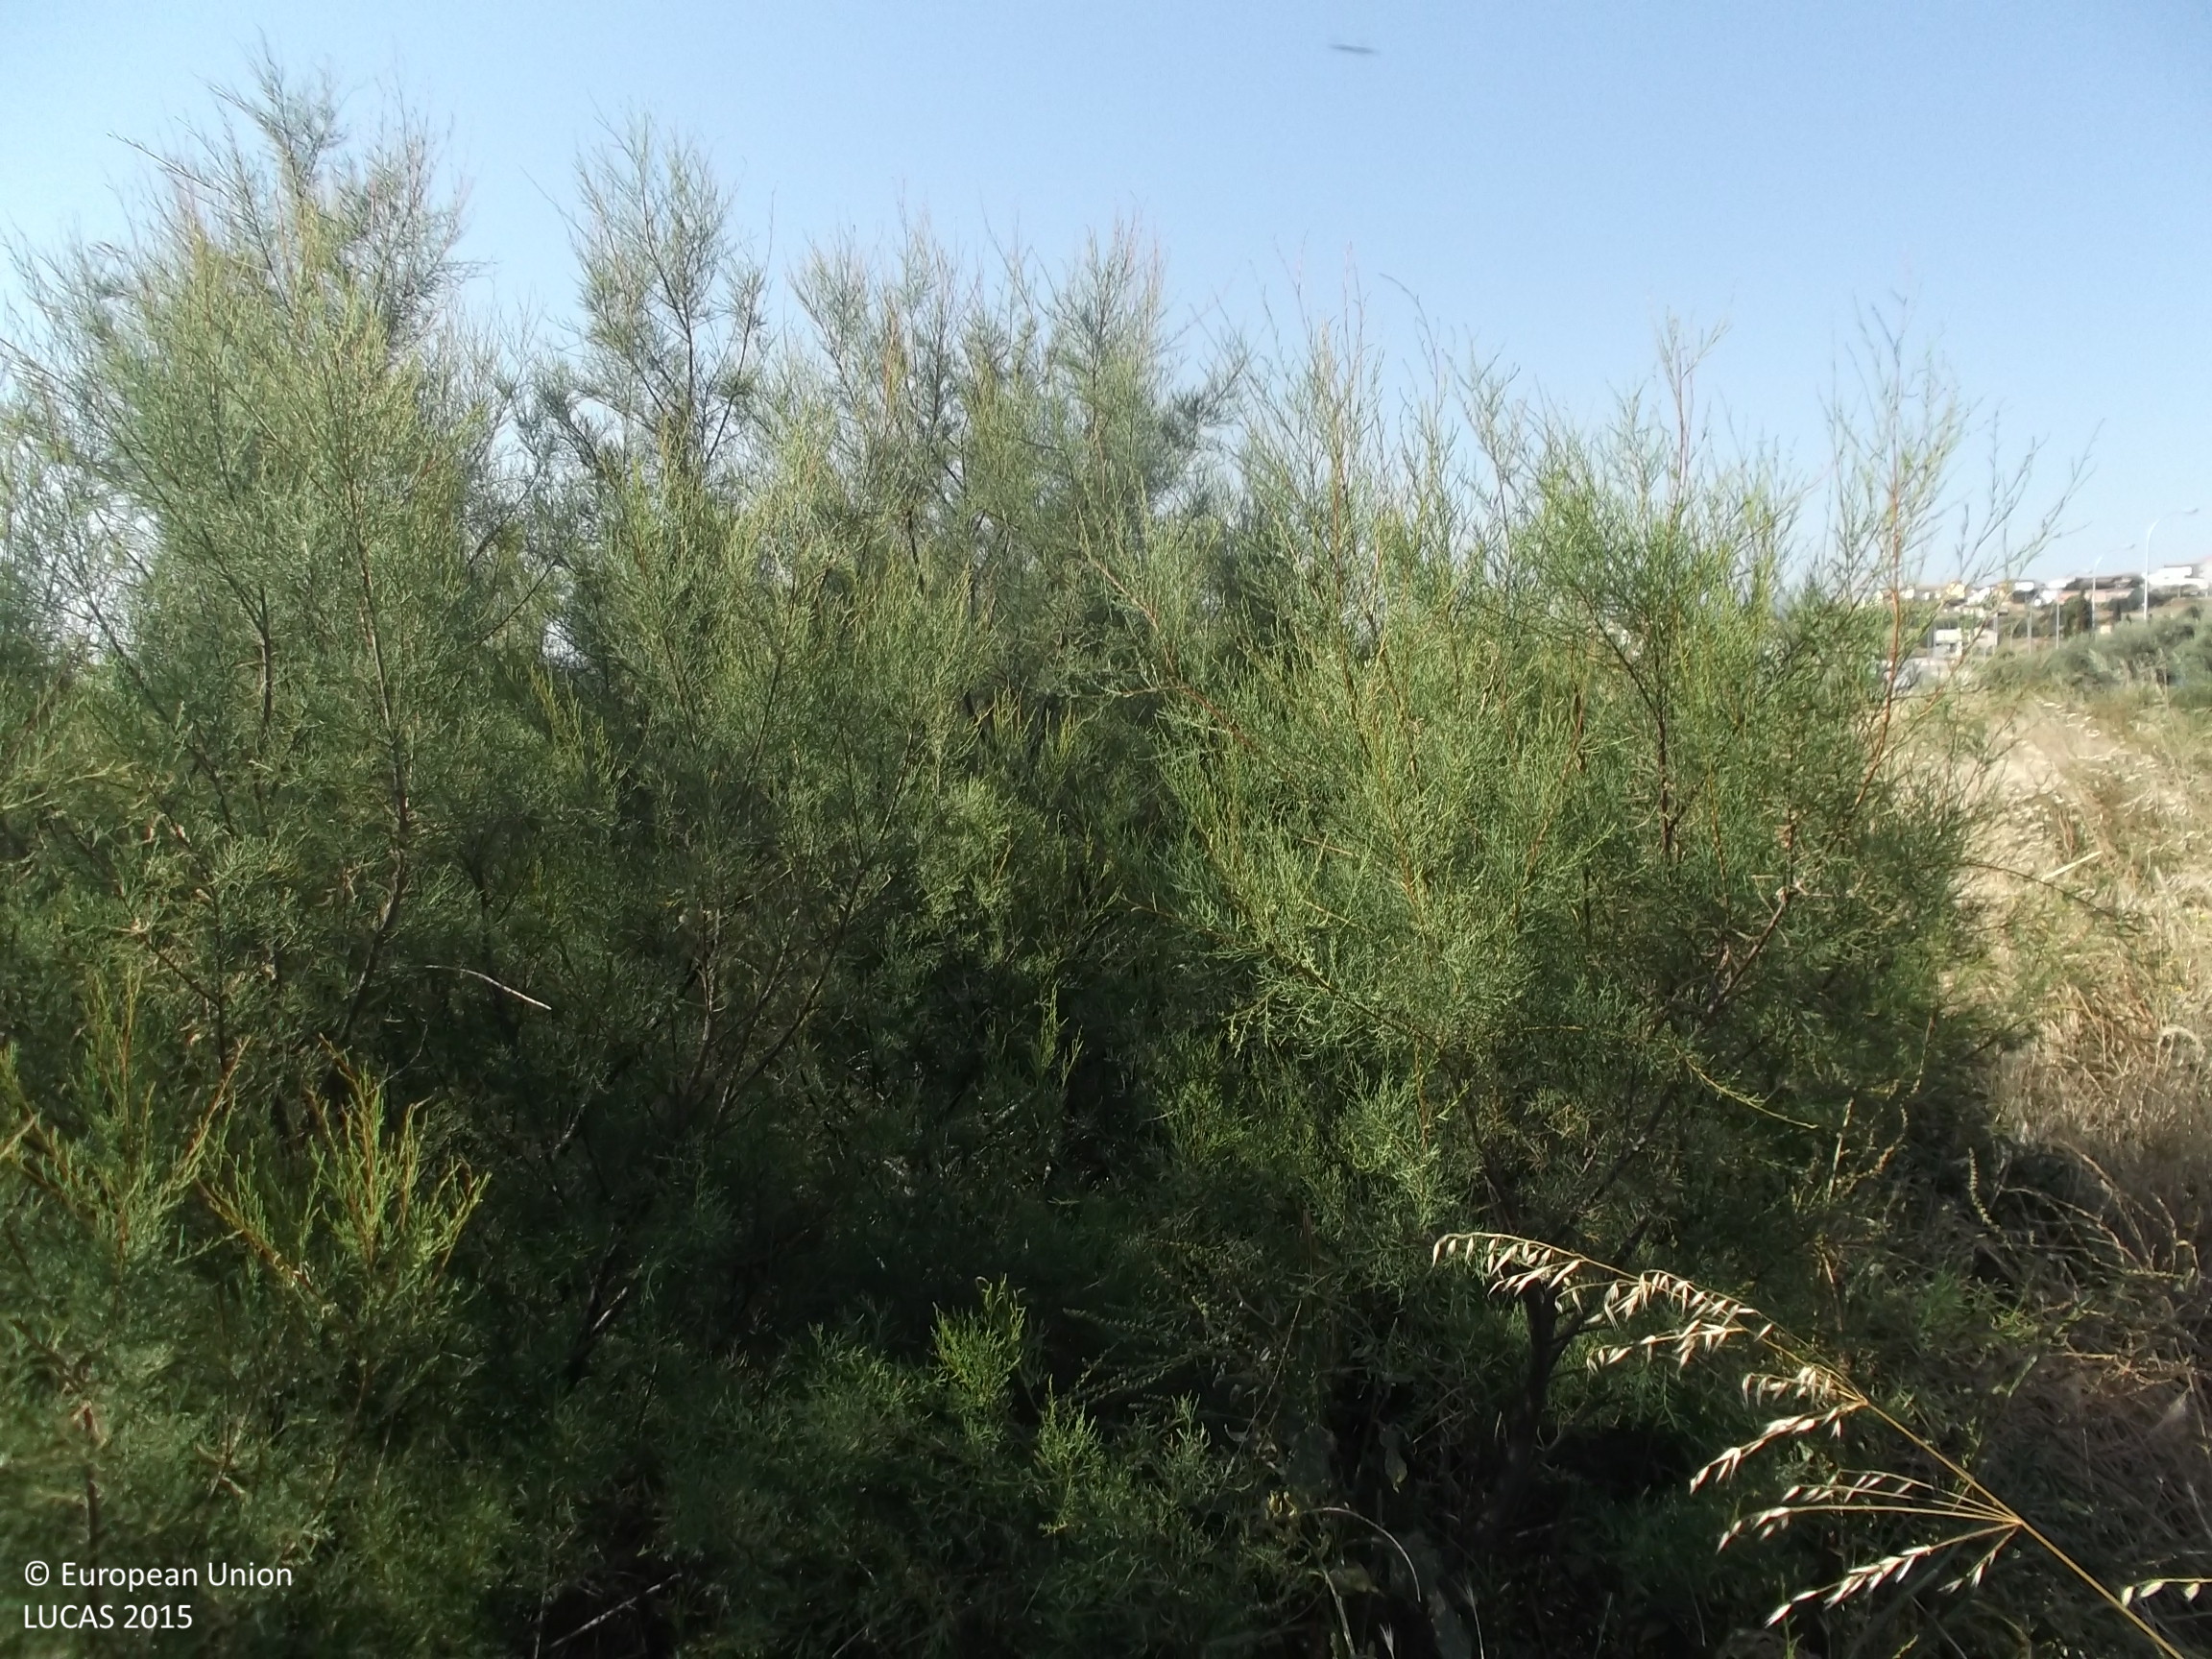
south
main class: Grassland
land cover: Spontaneously vegetated surfaces
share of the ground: > 75 %
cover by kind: herbaceous plants 95 %
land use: Abandoned areas
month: June
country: ES
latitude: 42.3283
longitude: -2.0898
